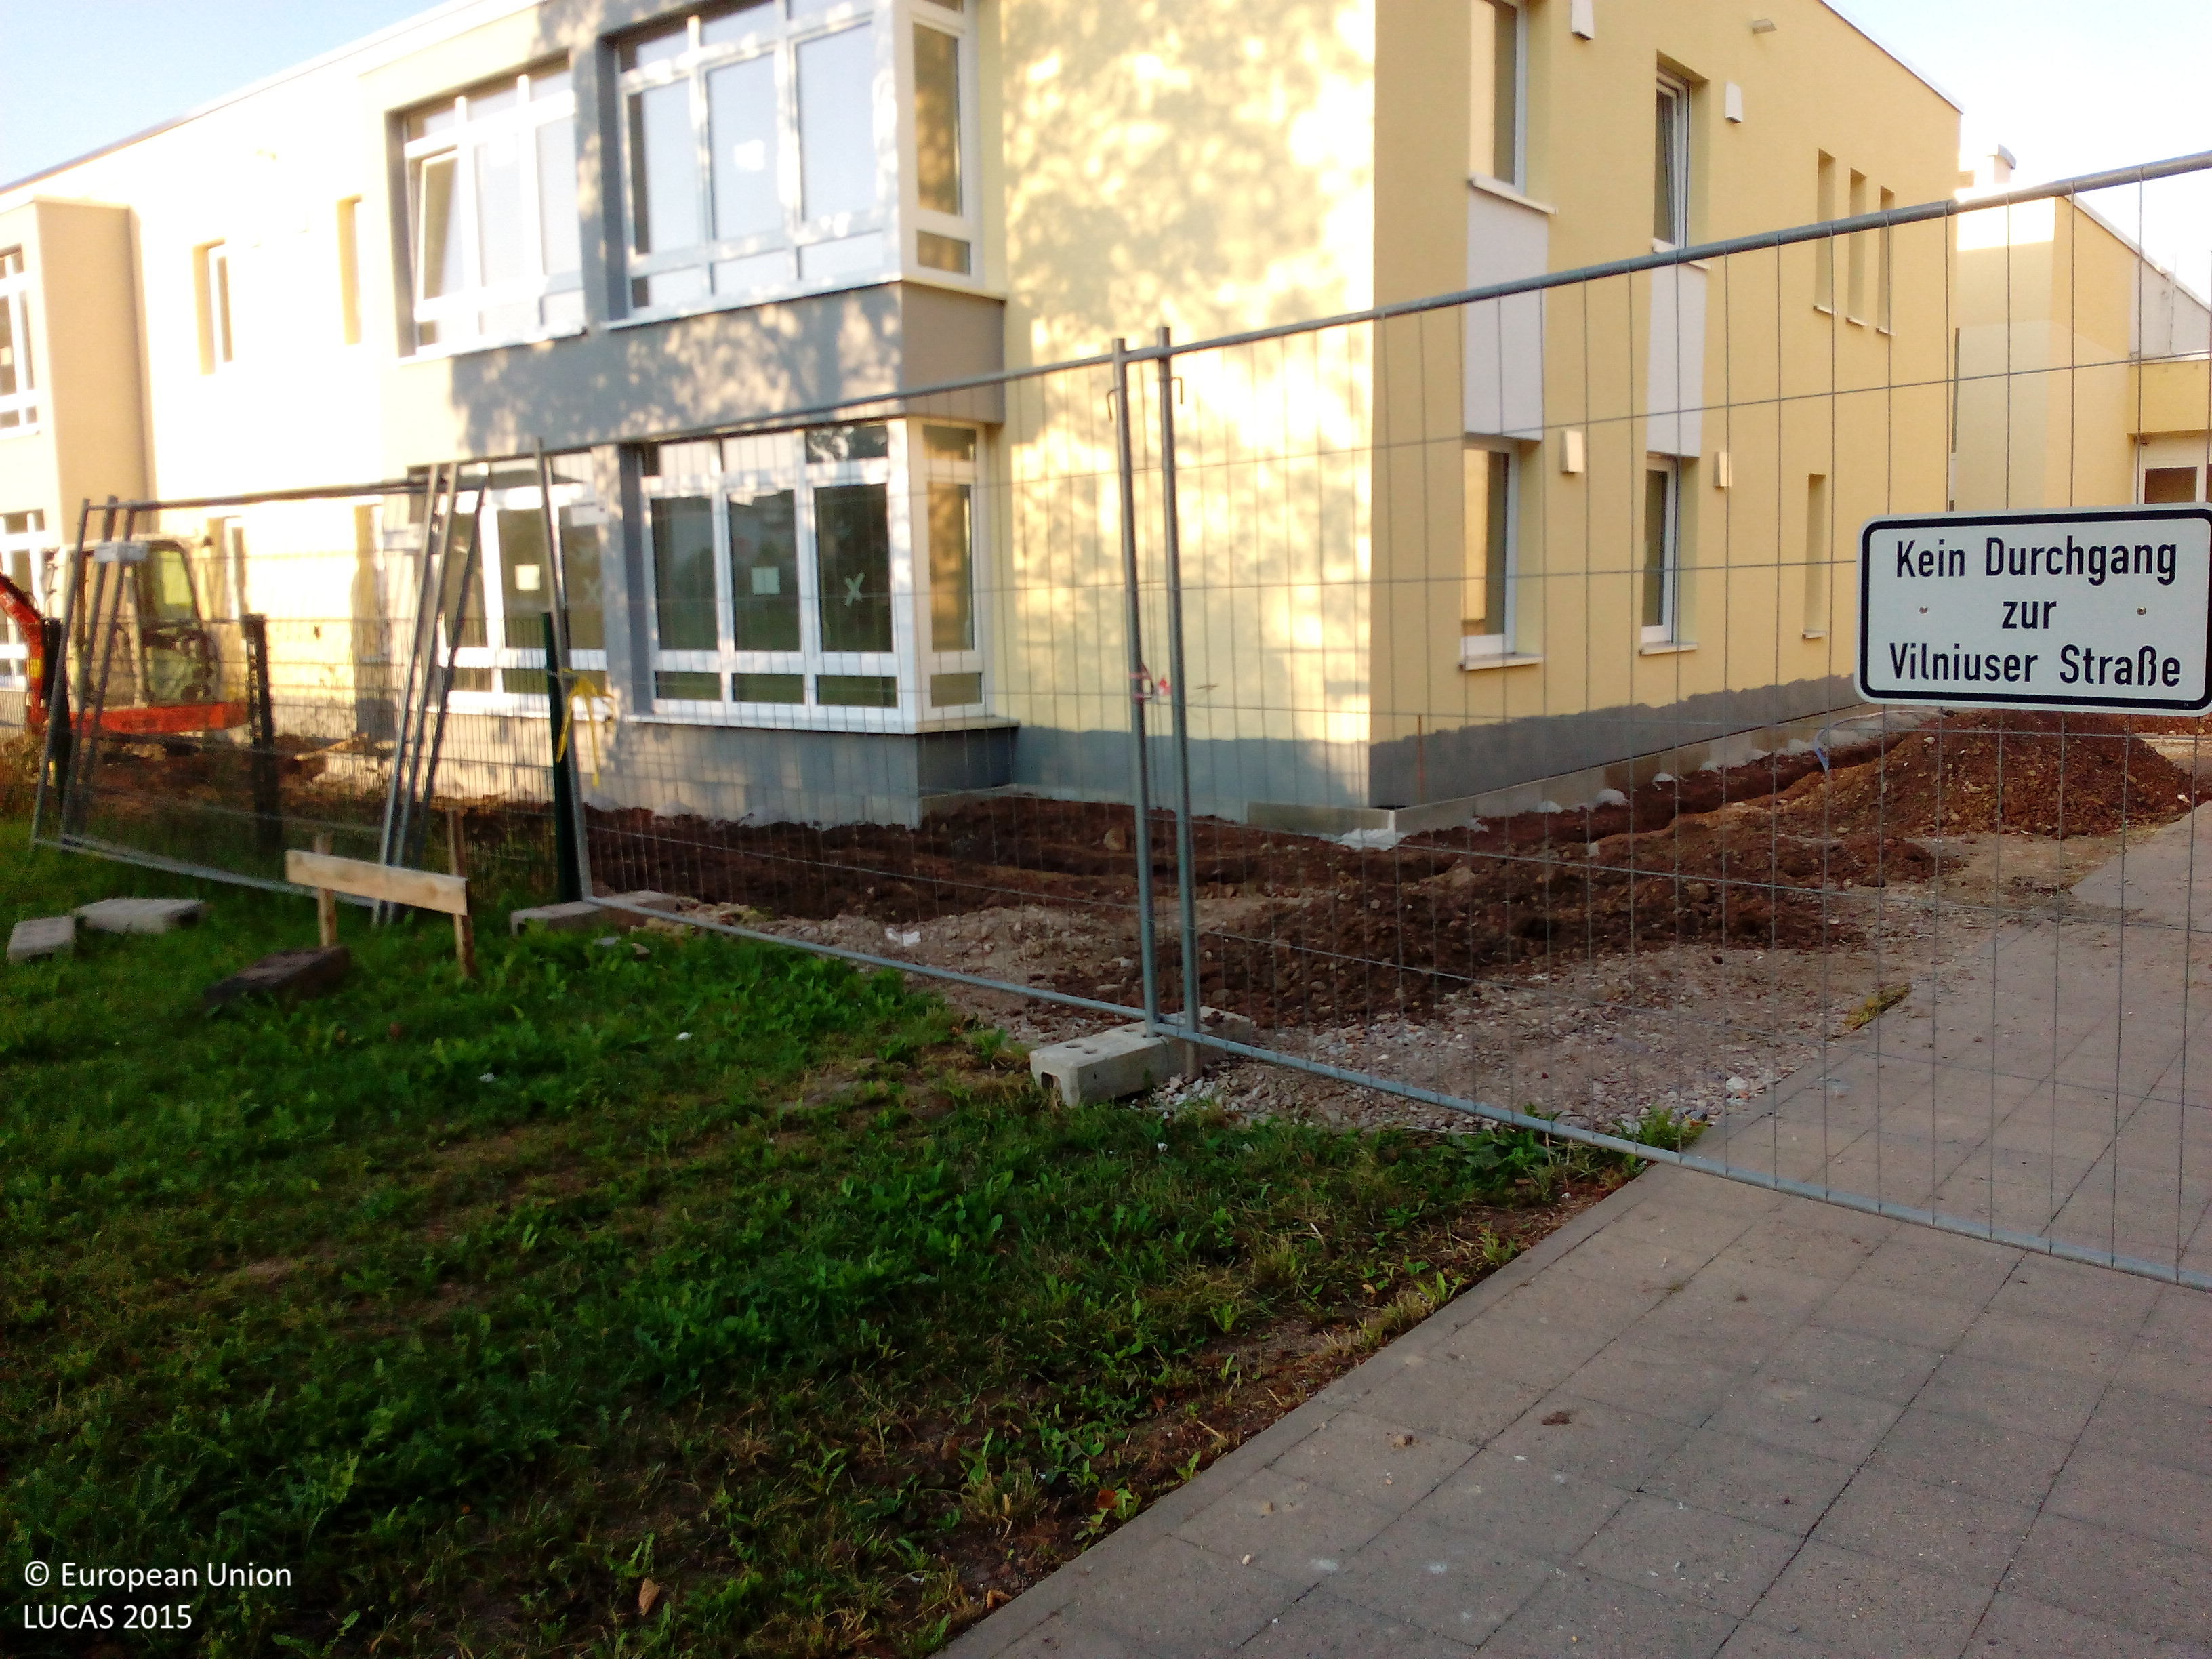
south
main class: Woodland
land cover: Broadleaved woodland
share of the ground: 25 - 50 %
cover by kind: herbaceous plants 45 %, broadleaved forest trees 40 %, consolidated bare surface 10 %, shrubs 5 %
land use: Residential
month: August
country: DE
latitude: 51.0069
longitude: 11.0116
